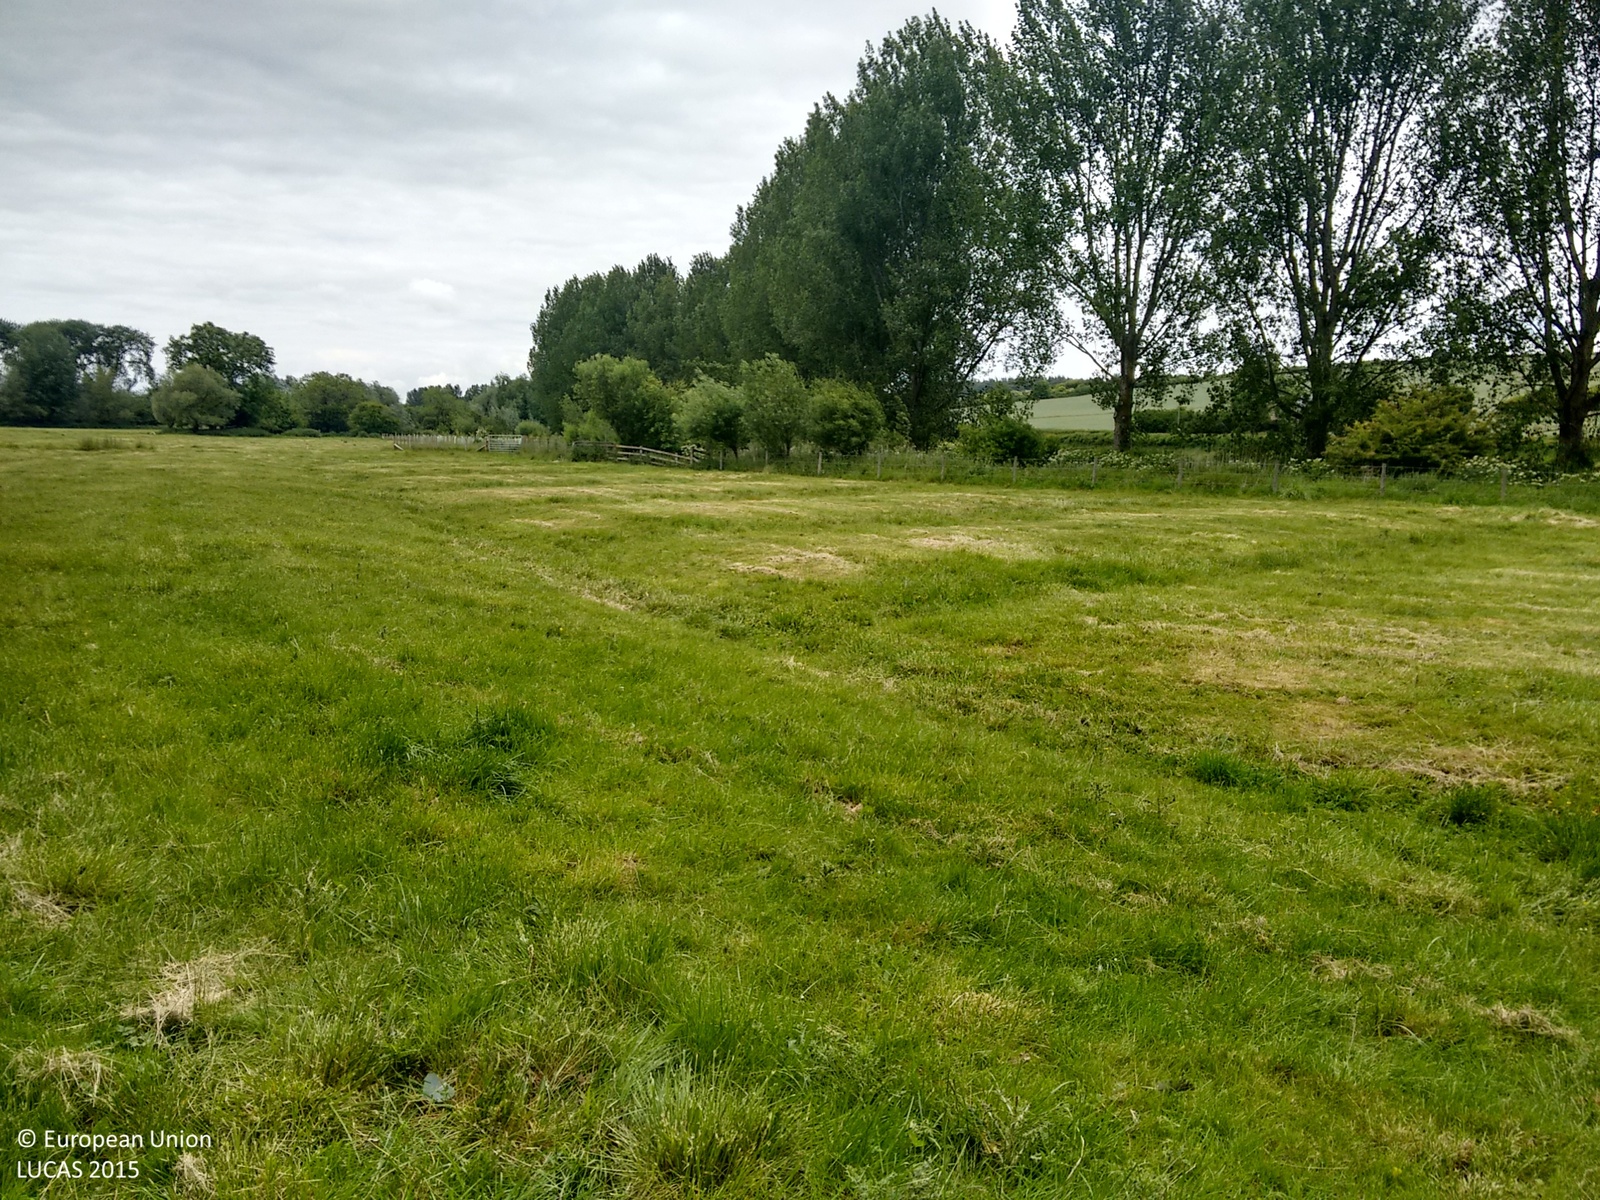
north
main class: Grassland
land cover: Grassland without tree/shrub cover
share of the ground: > 75 %
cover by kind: herbaceous plants 100 %
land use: Agriculture (excluding fallow land and kitchen gardens)
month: June
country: GB
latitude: 51.0893
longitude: -1.8636
